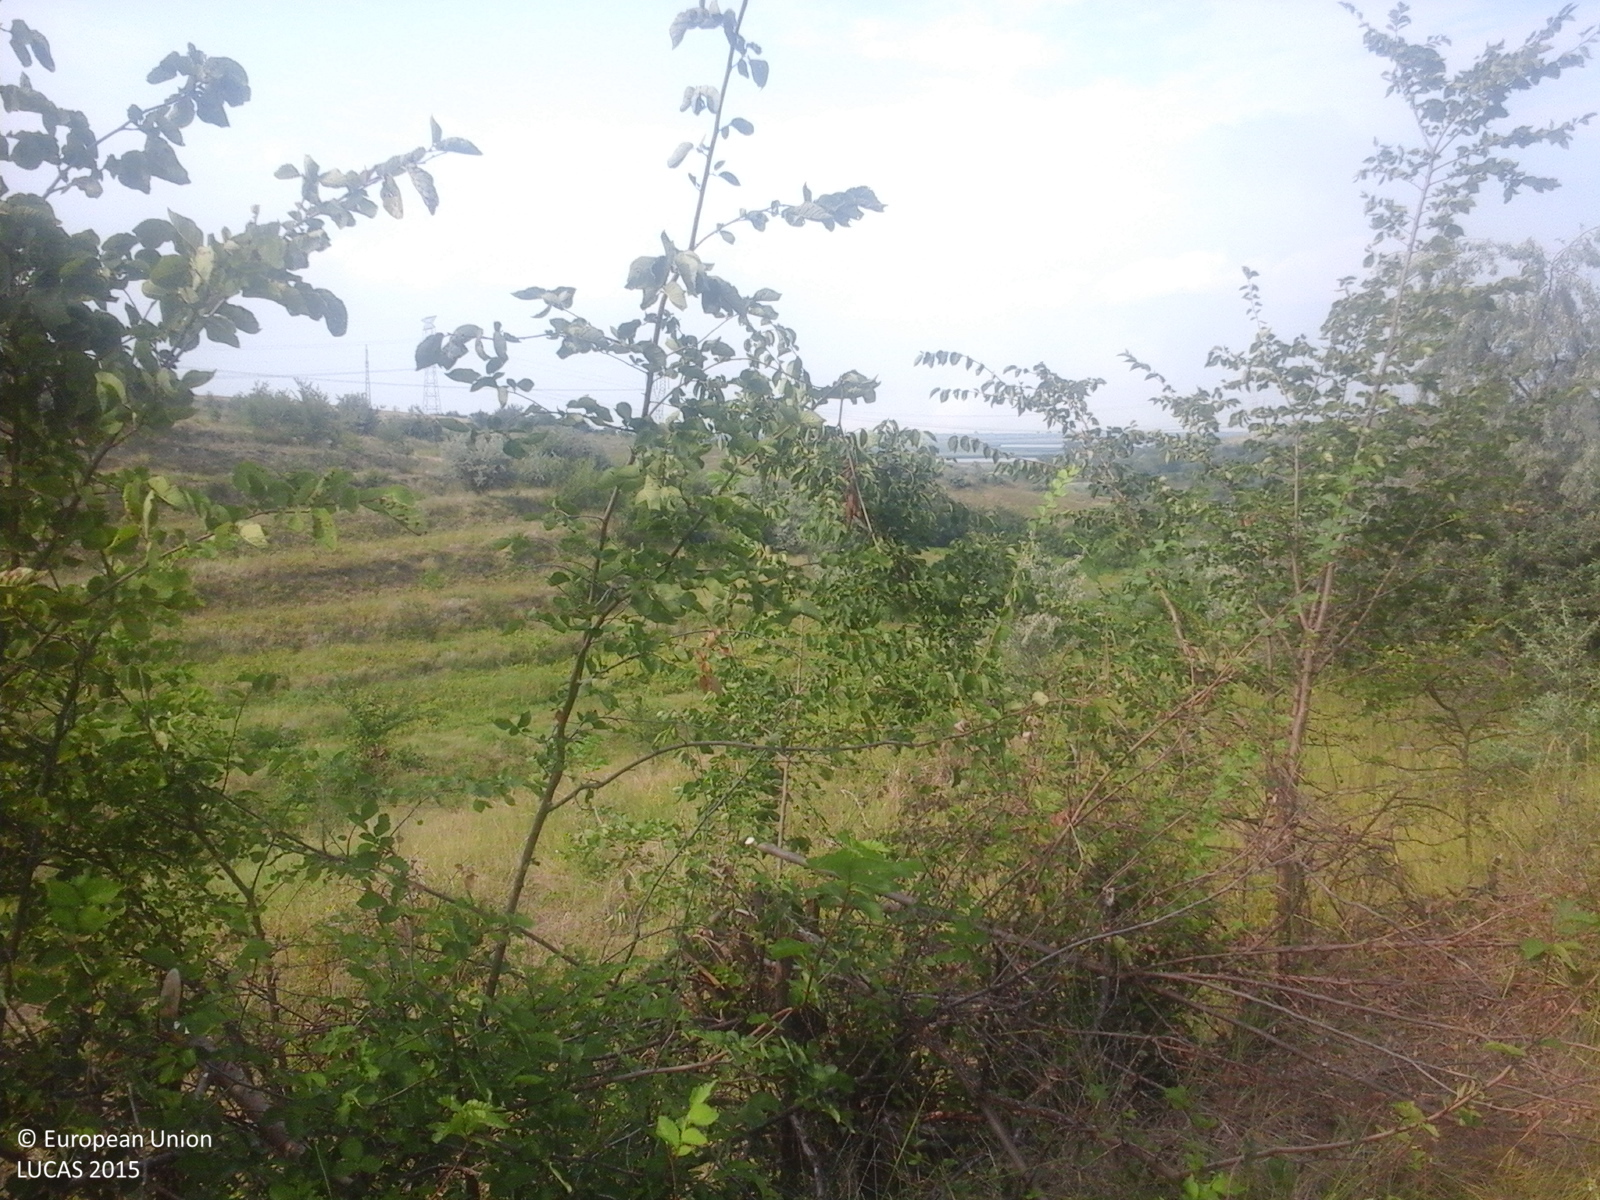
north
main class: Grassland
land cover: Grassland with sparse tree/shrub cover
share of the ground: > 75 %
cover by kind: herbaceous plants 85 %, shrubs 10 %, broadleaved forest trees 5 %
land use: Agriculture (excluding fallow land and kitchen gardens)
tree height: < 5 m
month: July
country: RO
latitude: 45.2647
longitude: 28.3384
